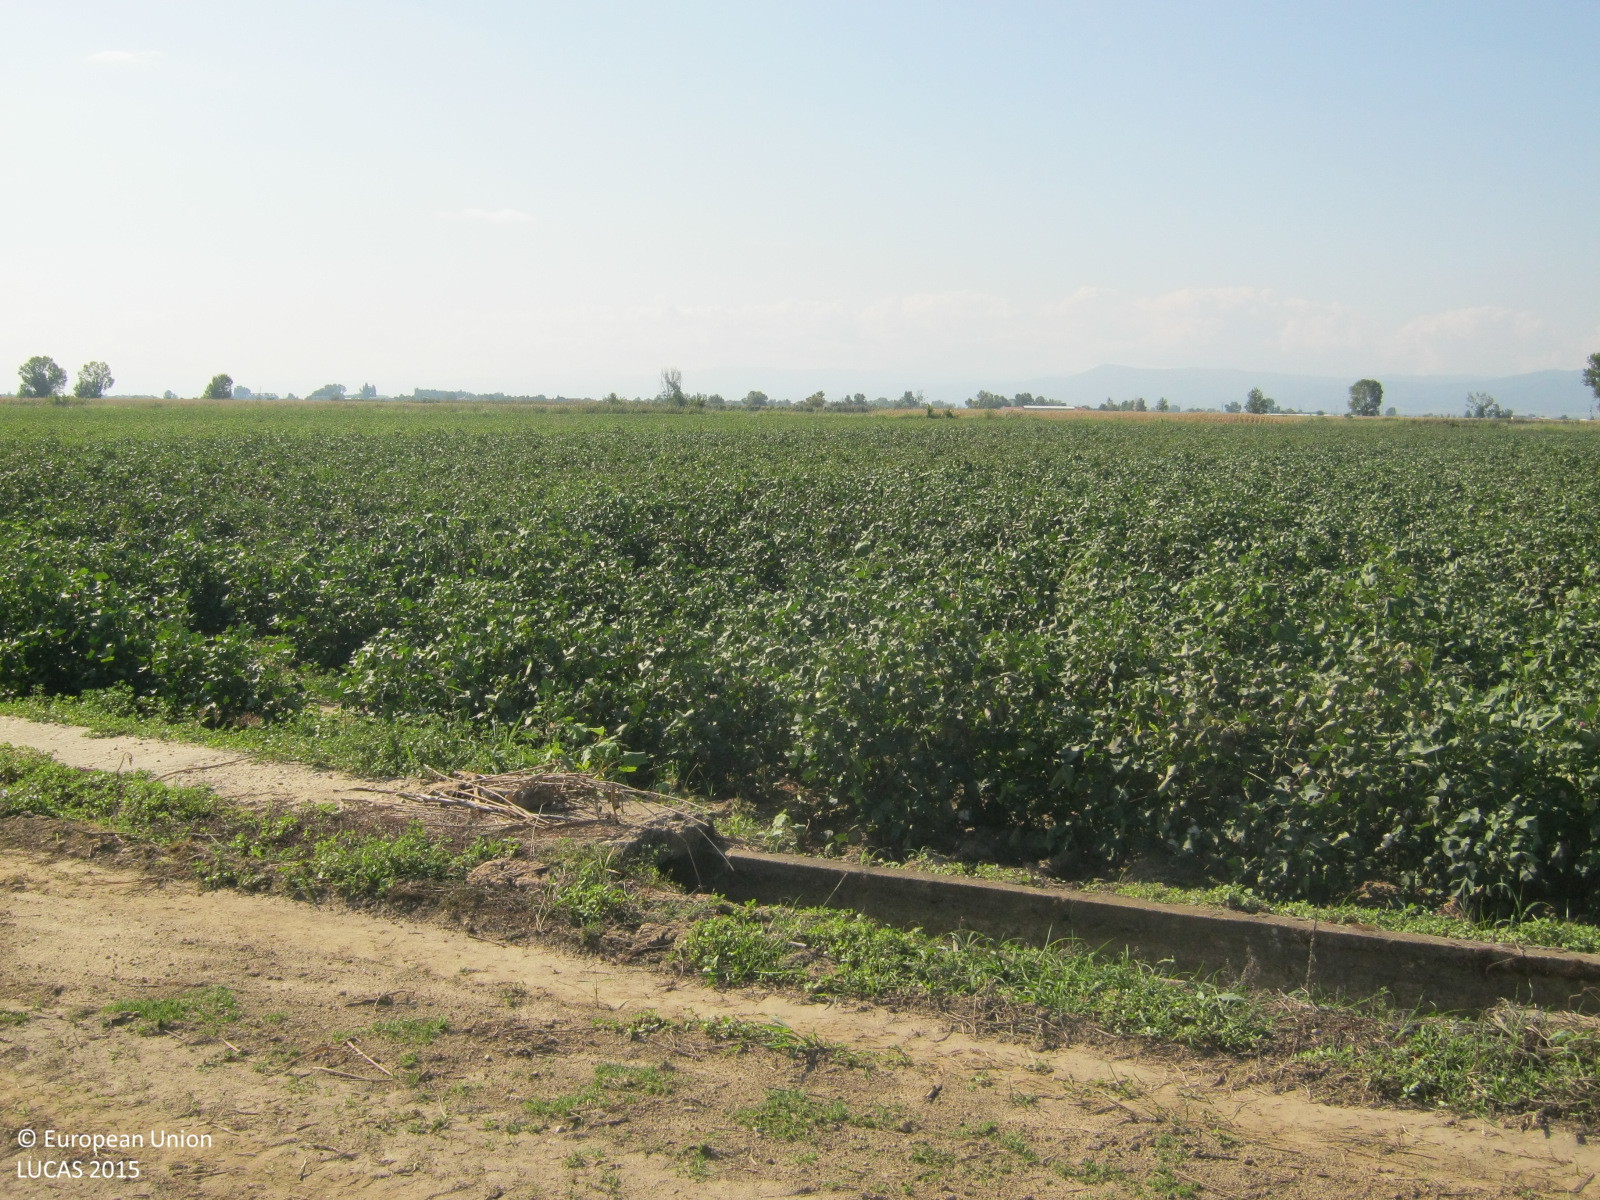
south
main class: Cropland
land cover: Cotton
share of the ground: > 75 %
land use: Agriculture (excluding fallow land and kitchen gardens)
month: September
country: GR
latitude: 41.2037
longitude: 23.3150
